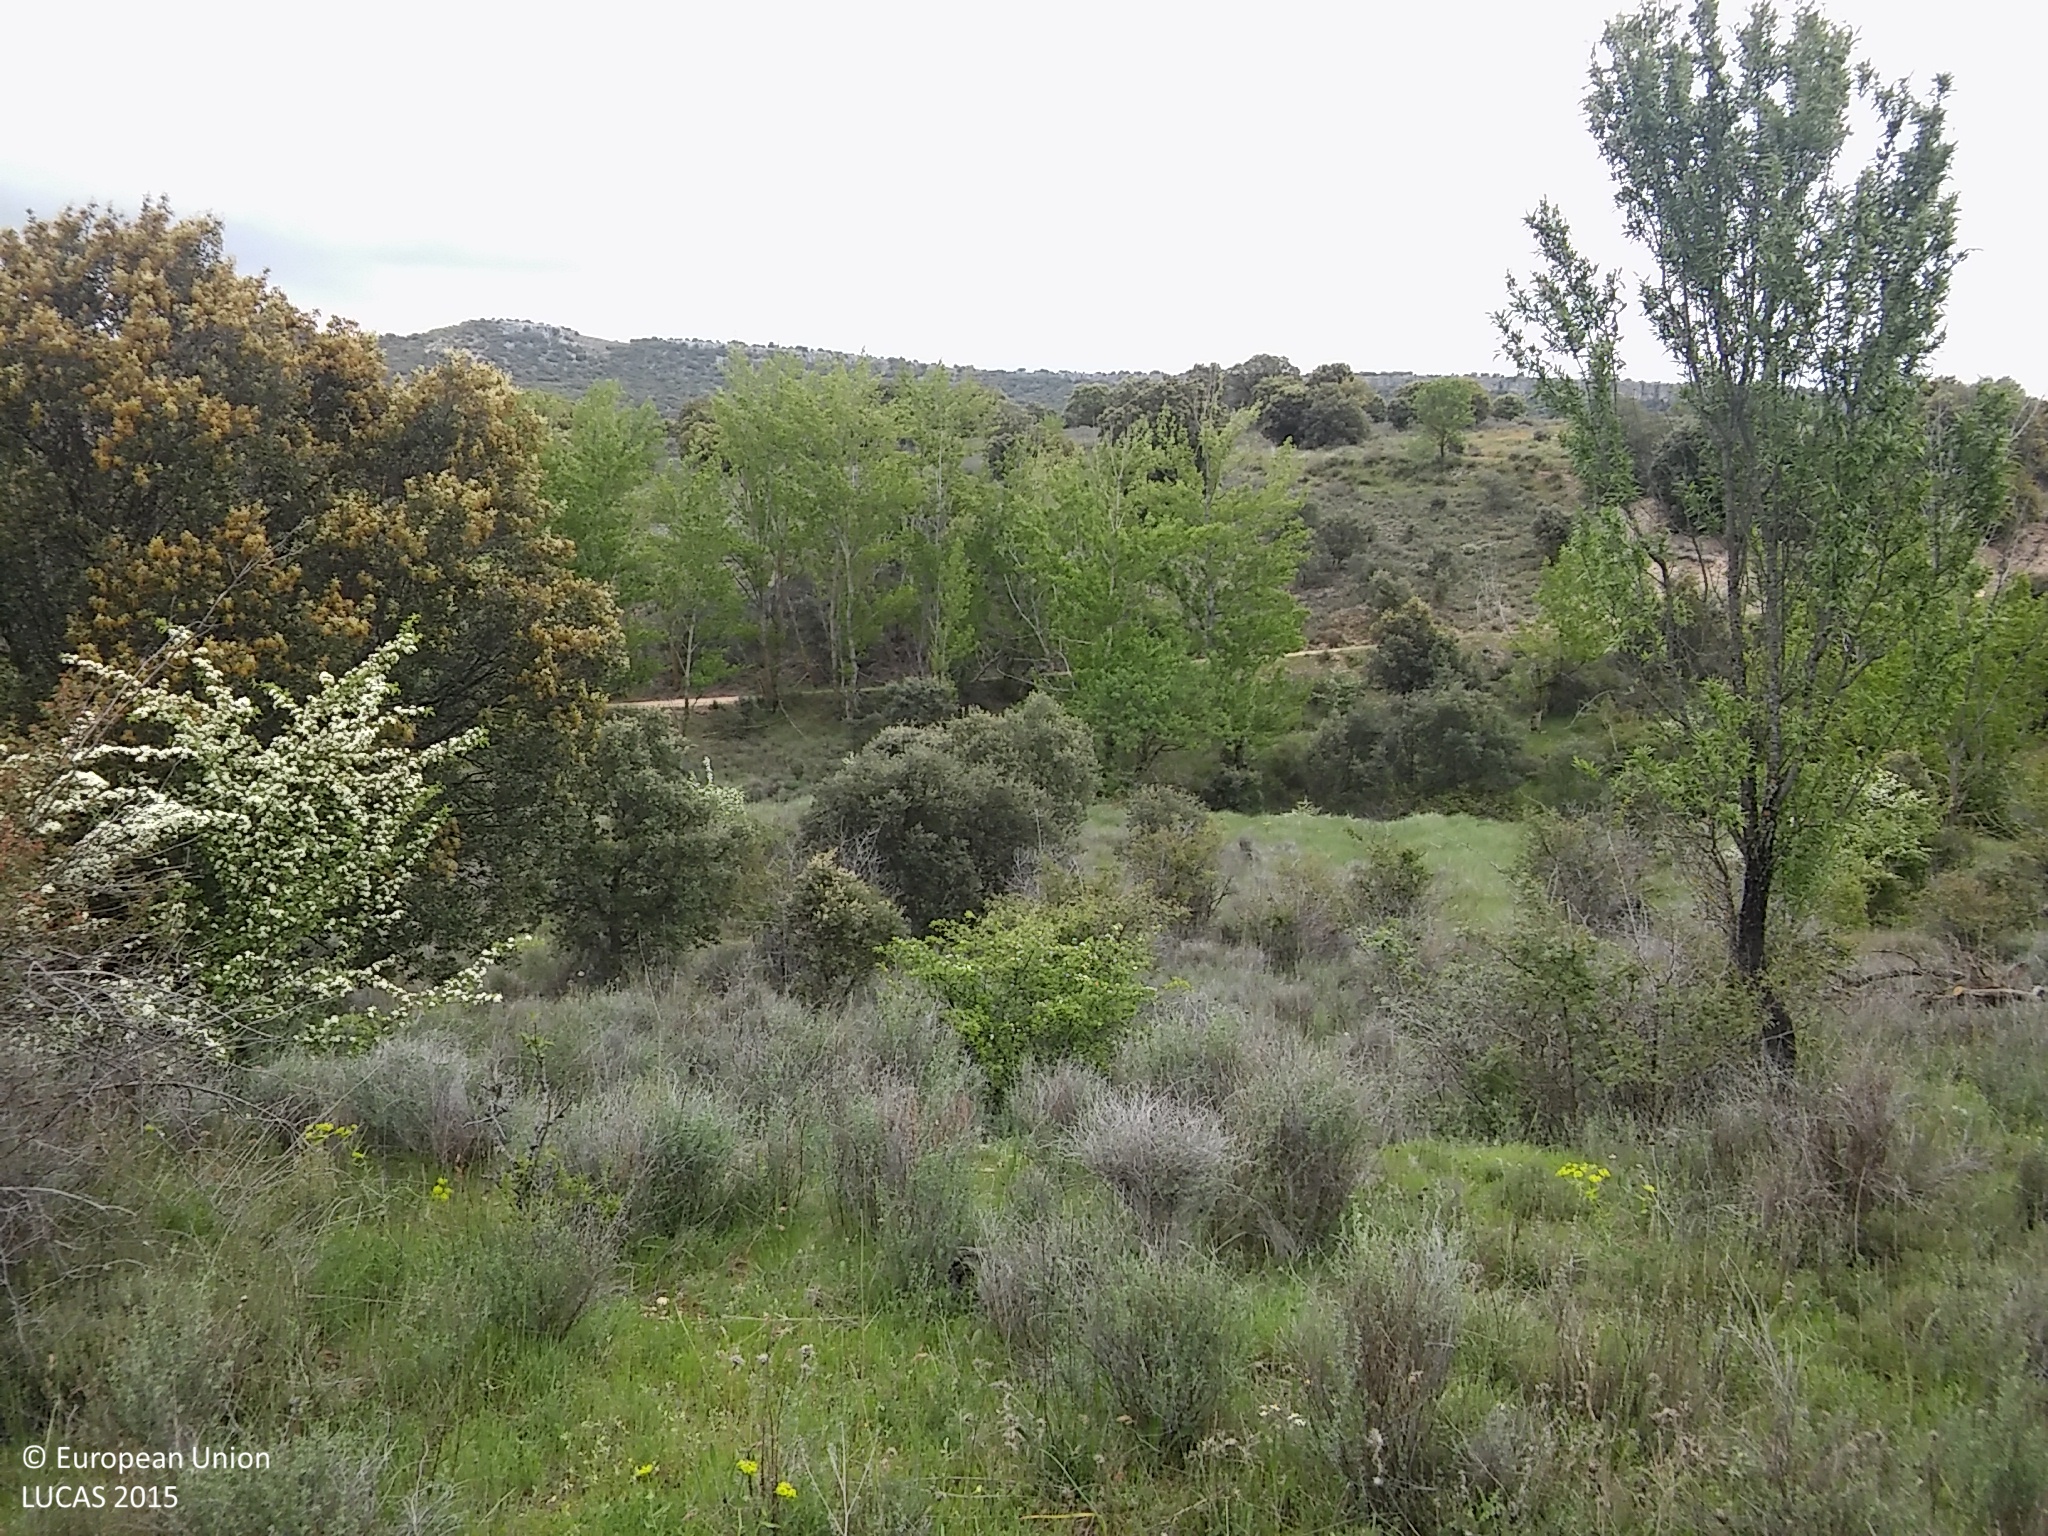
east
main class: Shrubland
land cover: Shrubland with sparse tree cover
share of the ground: 25 - 50 %
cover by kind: herbaceous plants 55 %, shrubs 30 %, unconsolidated bare surface 10 %, broadleaved forest trees 5 %
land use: Semi-natural and natural areas not in use
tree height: > 5 m
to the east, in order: Shrubland with sparse tree cover; Grassland with sparse tree/shrub cover; Rivers and streams; Broadleaved woodland; Tracks; Broadleaved woodland; Shrubland with sparse tree cover; Vineyards; Shrubland with sparse tree cover; Tracks; Shrubland with sparse tree cover
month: May
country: ES
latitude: 41.4242
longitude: -3.9699
